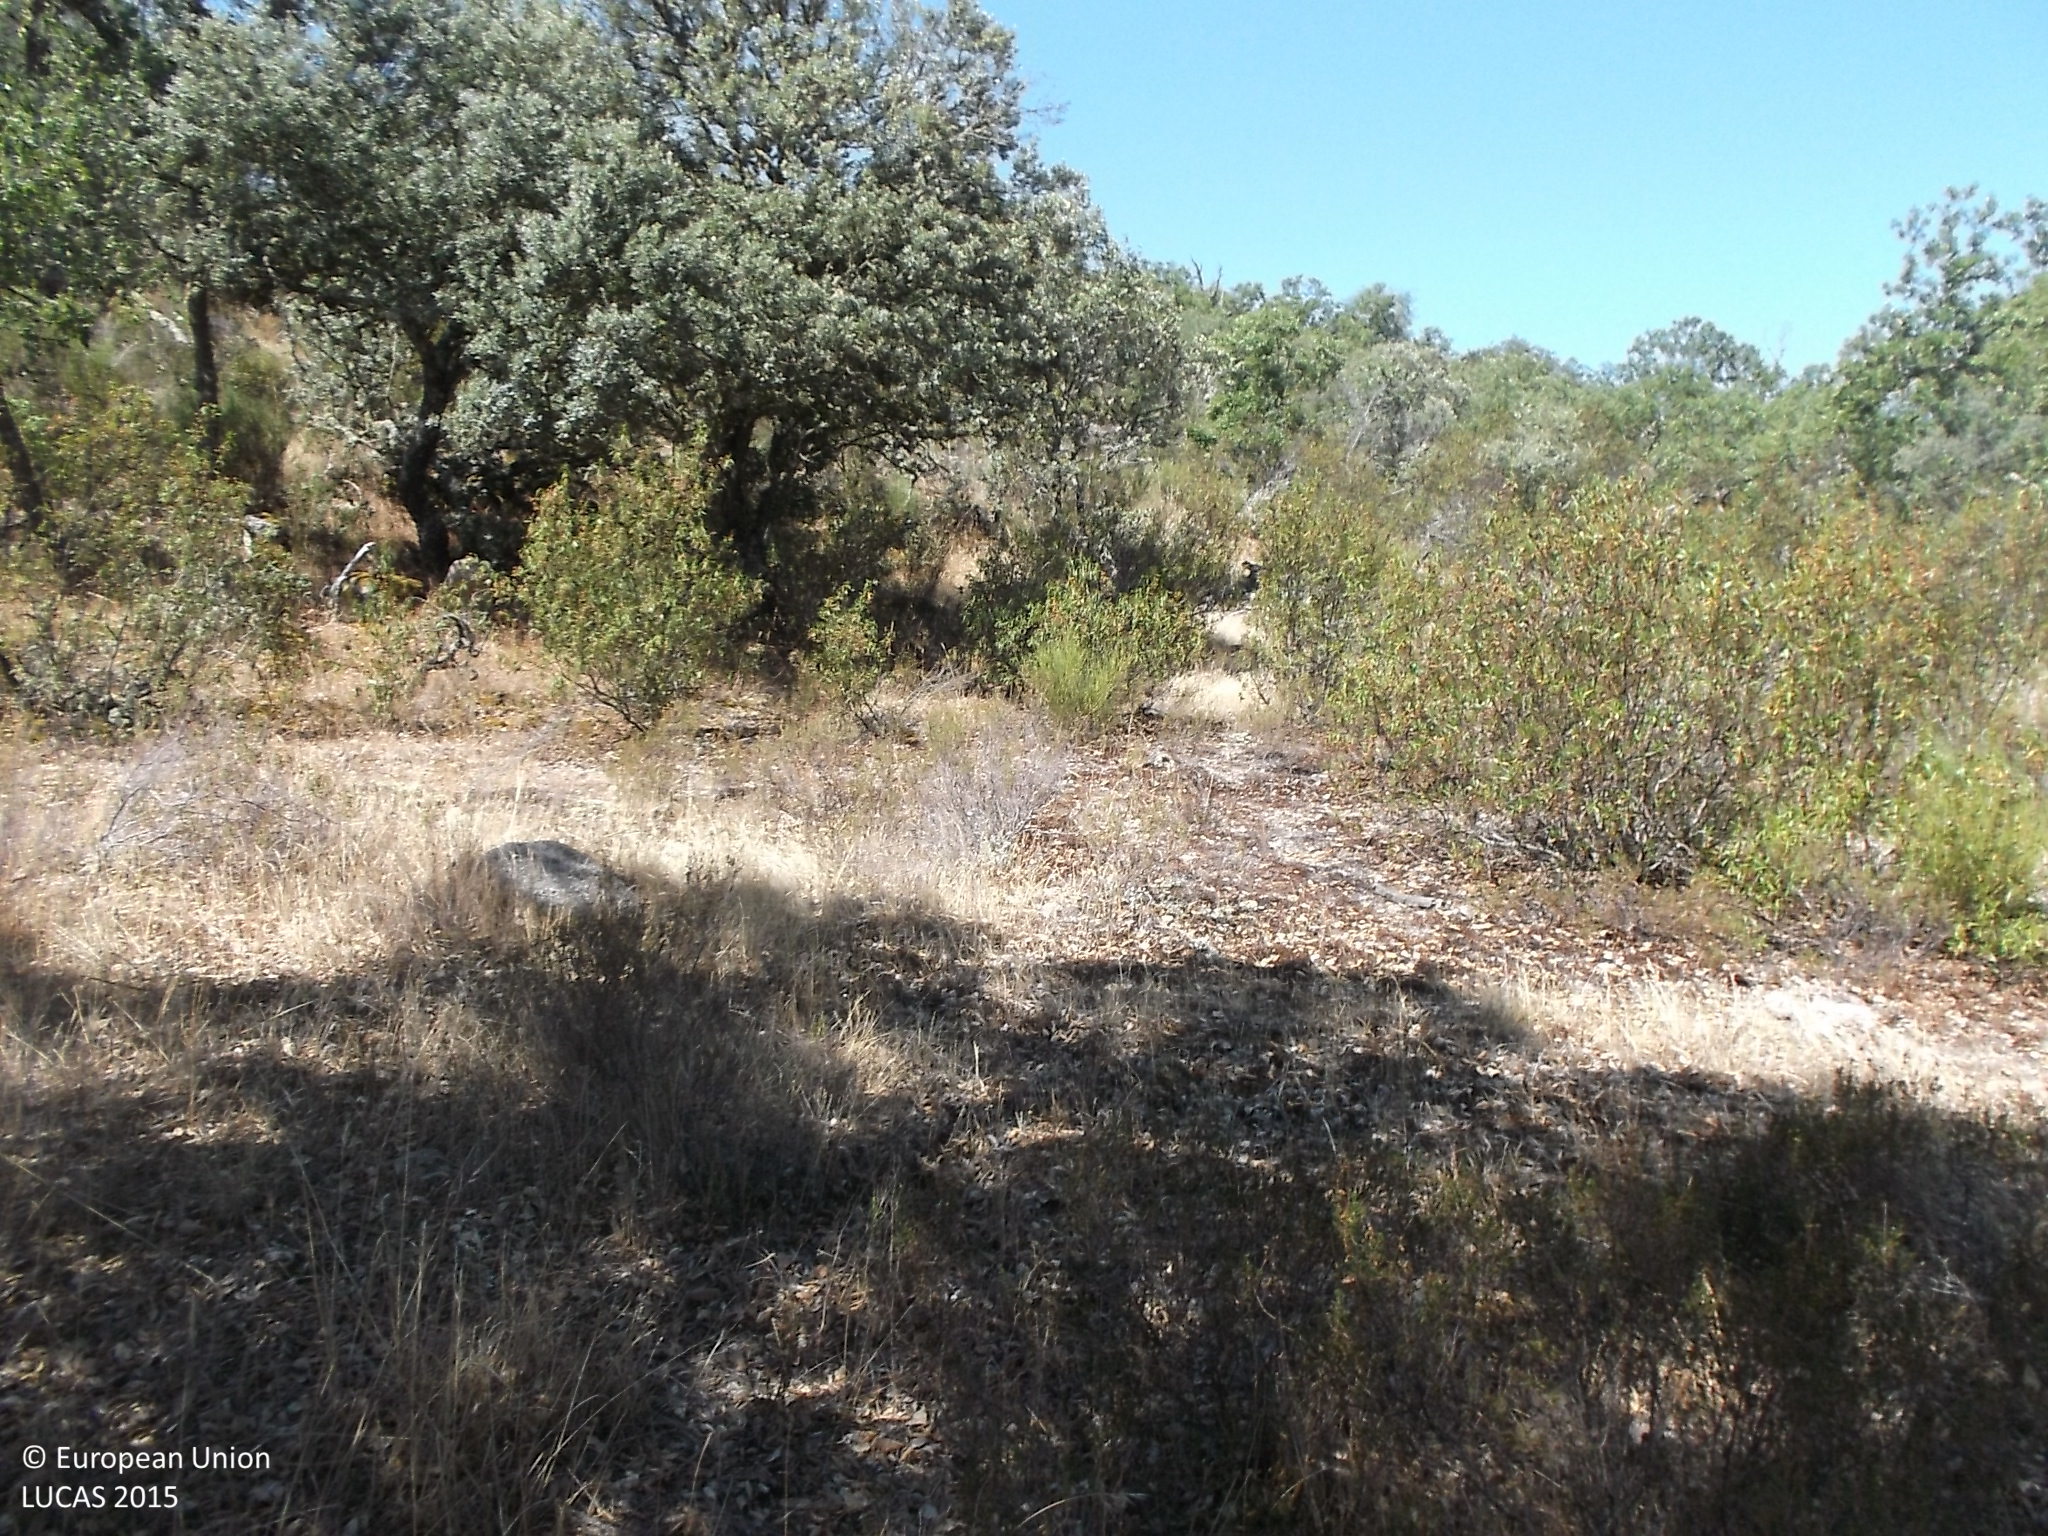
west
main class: Woodland
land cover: Broadleaved woodland
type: broadleaved evergreen forest
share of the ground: 25 - 50 %
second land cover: Shrubland without tree cover
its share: 25 - 50 %
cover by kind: broadleaved forest trees 50 %, shrubs 30 %, herbaceous plants 20 %
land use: Forestry
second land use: Agriculture (excluding fallow land and kitchen gardens)
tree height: < 5 m
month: July
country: ES
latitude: 41.3242
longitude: -5.8443
